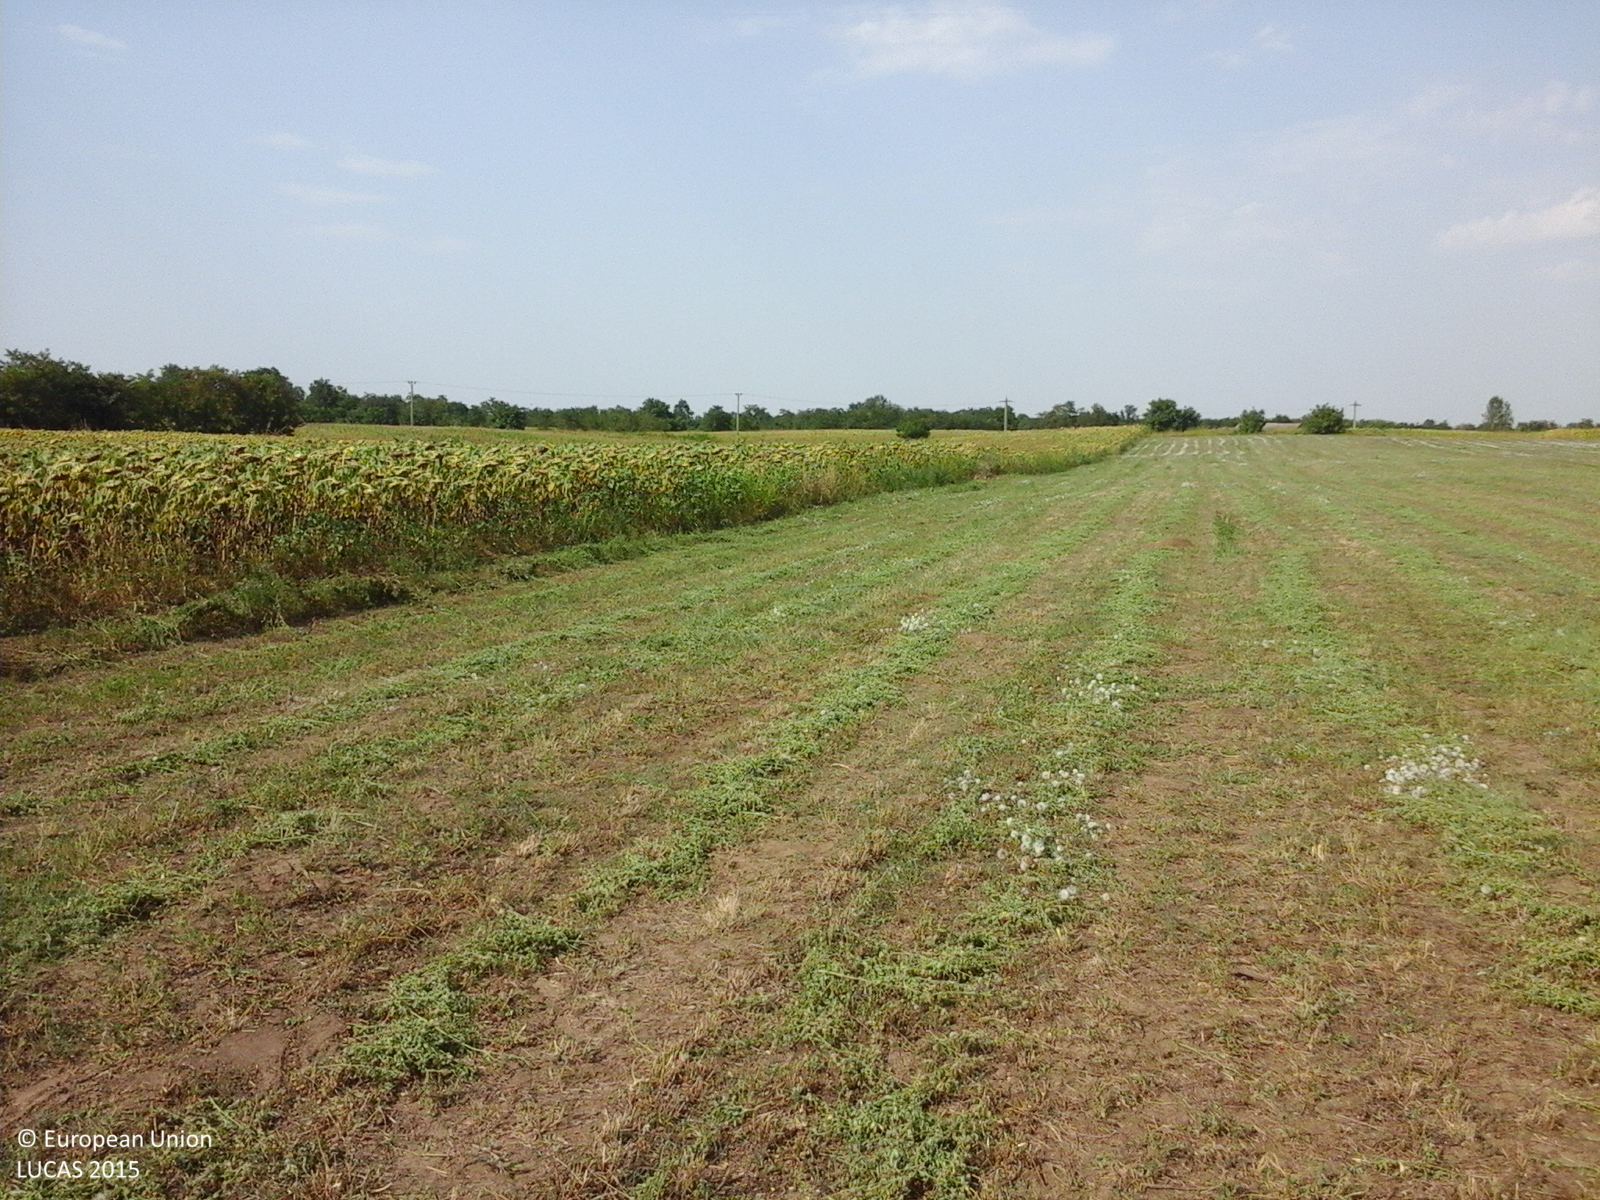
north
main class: Cropland
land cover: Lucerne
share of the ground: 50 - 75 %
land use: Agriculture (excluding fallow land and kitchen gardens)
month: August
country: RO
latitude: 45.2846
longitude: 27.4767
